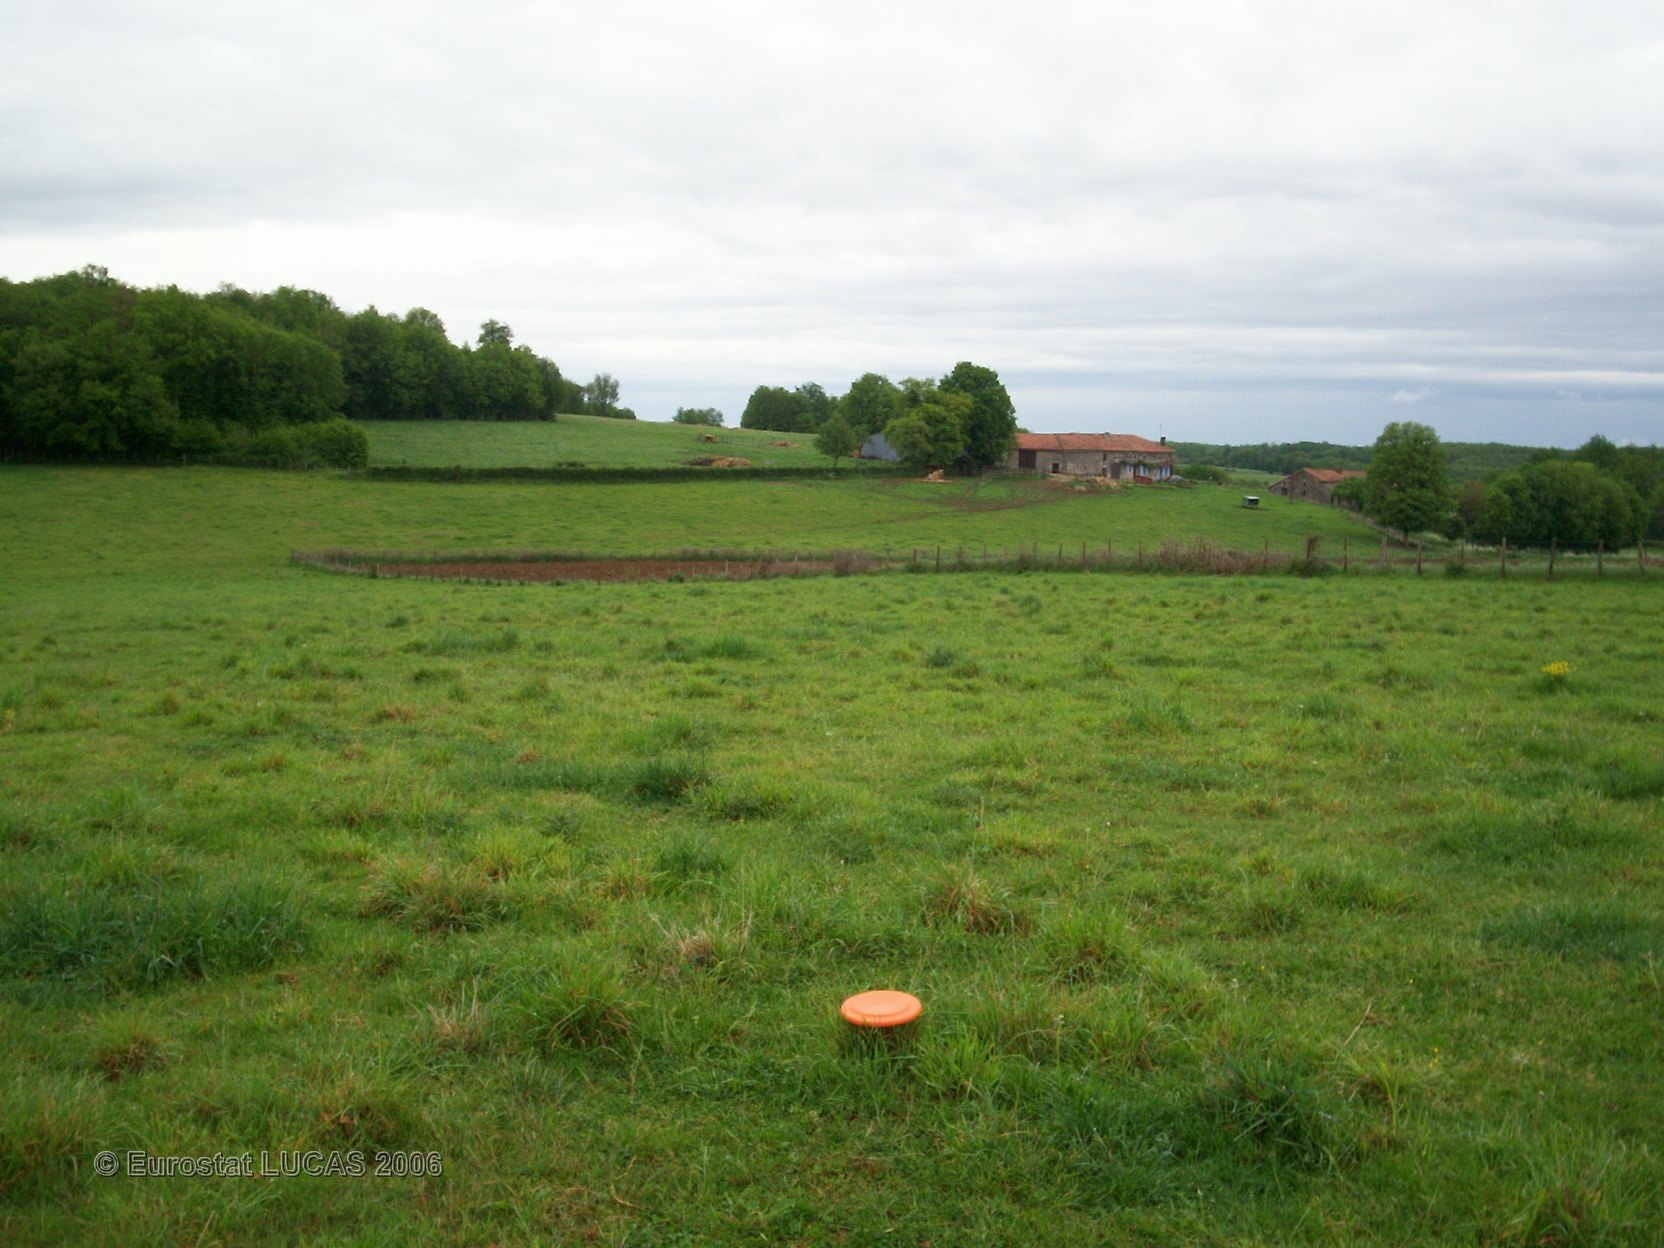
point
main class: Grassland
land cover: Grassland without tree/shrub cover
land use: Agriculture (excluding fallow land and kitchen gardens)
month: May
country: FR
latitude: 46.0485
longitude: 0.4334
